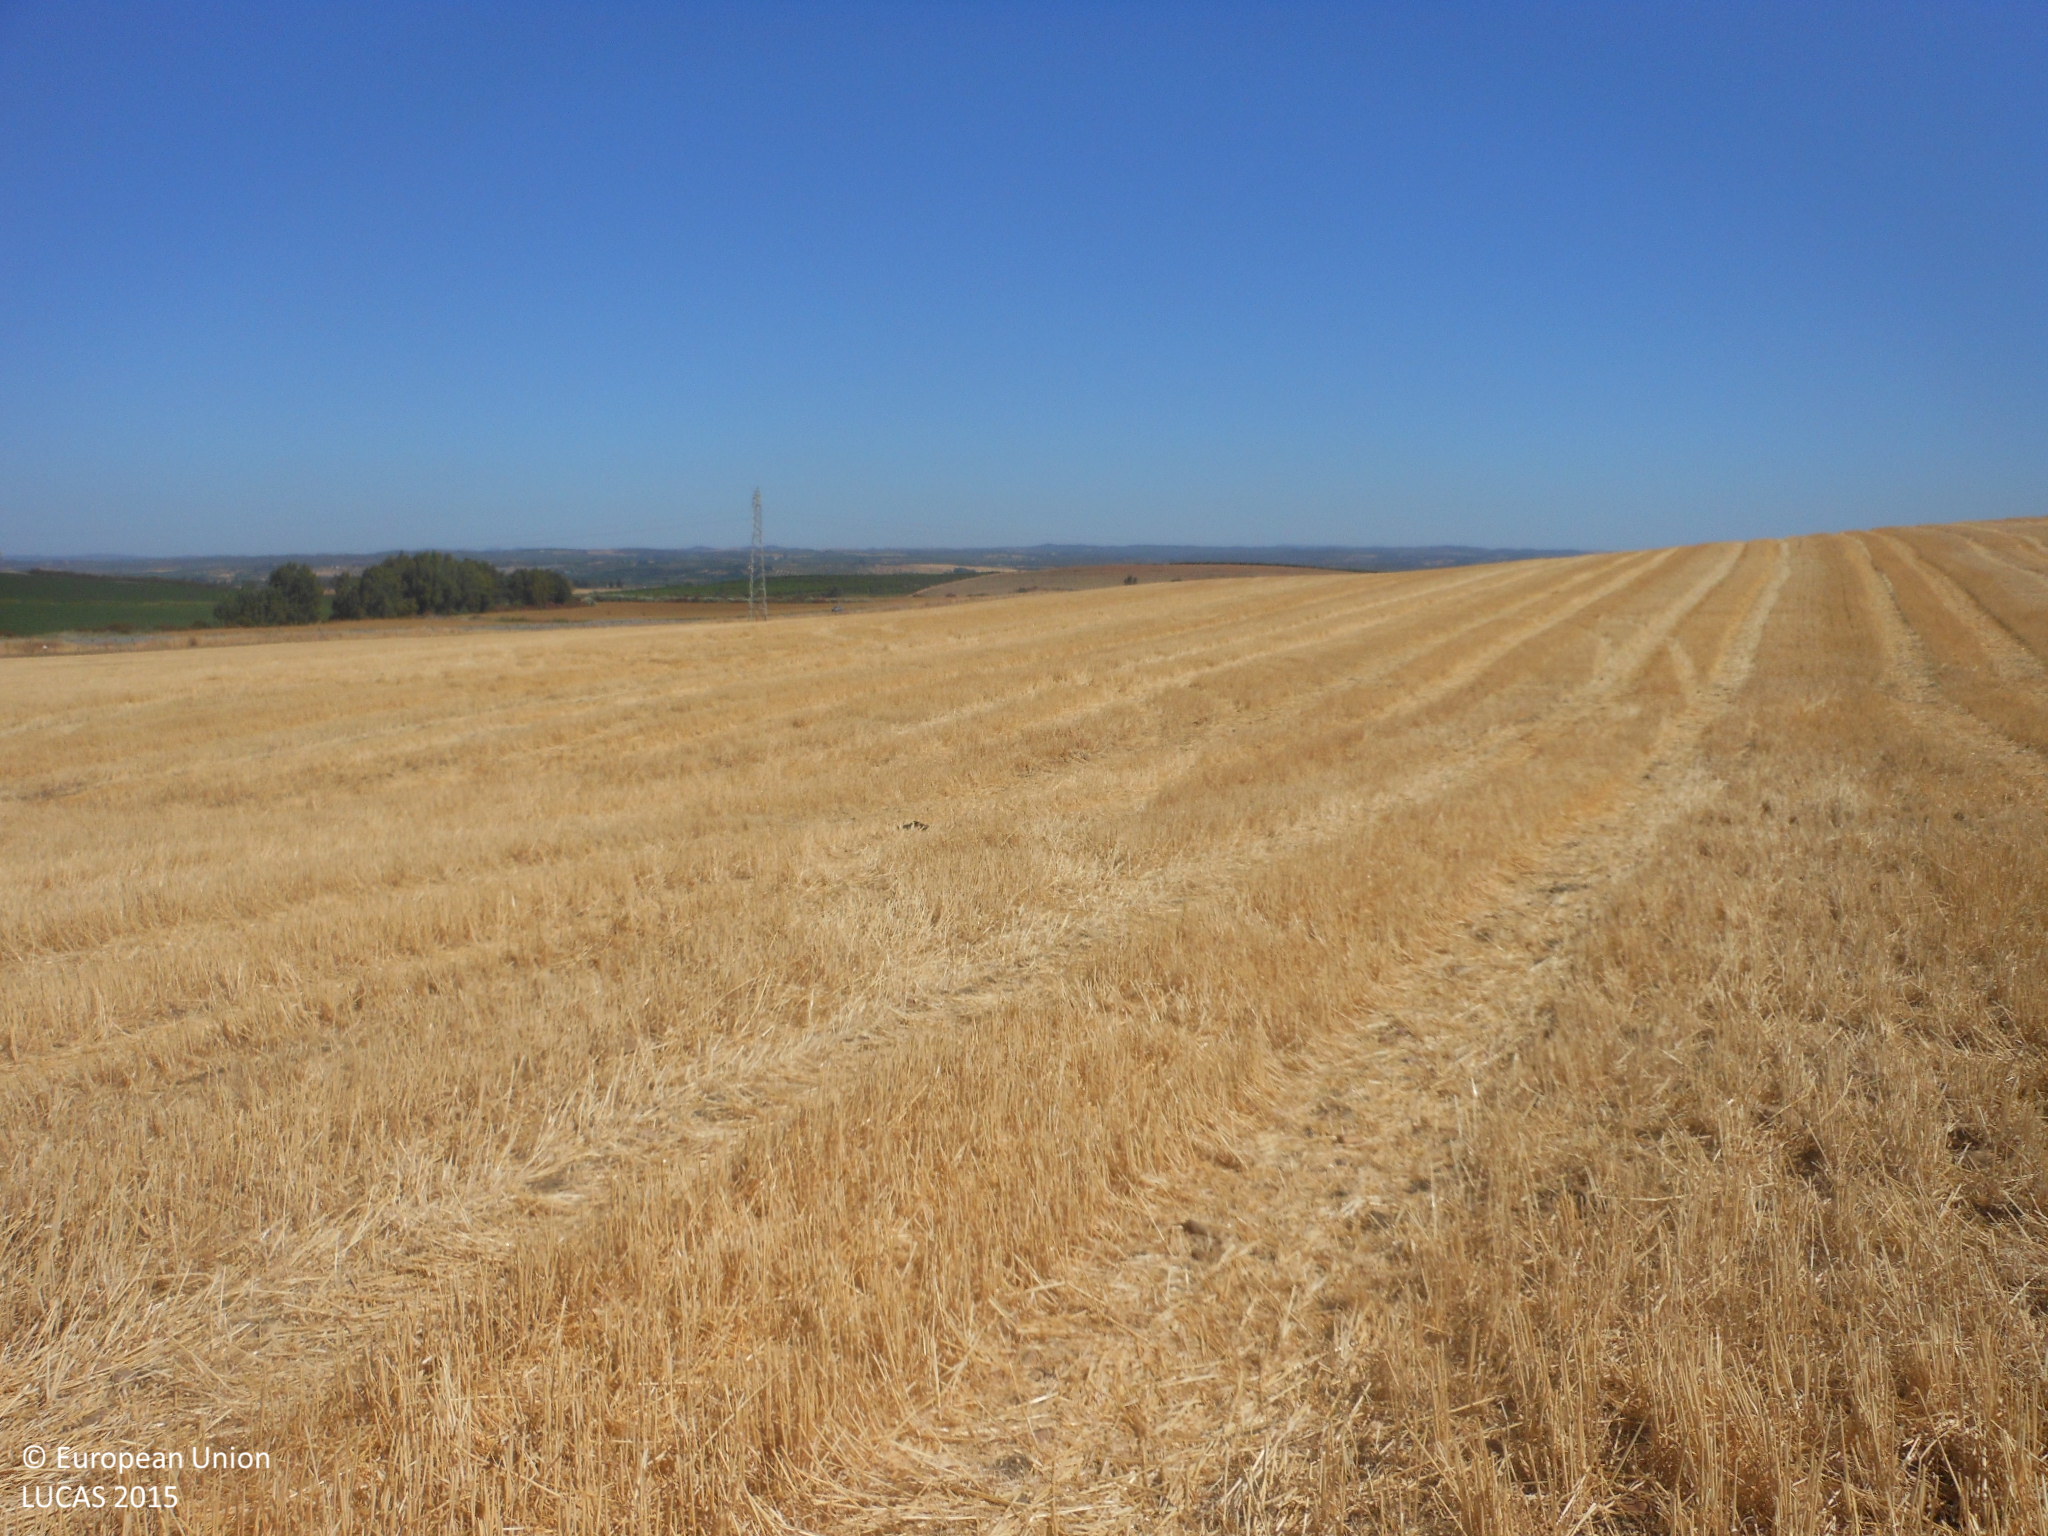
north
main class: Cropland
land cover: Barley
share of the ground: < 10 %
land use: Agriculture (excluding fallow land and kitchen gardens)
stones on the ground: 10 - 25 %
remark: Harvested field
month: July
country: ES
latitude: 37.5770
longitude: -5.5901
